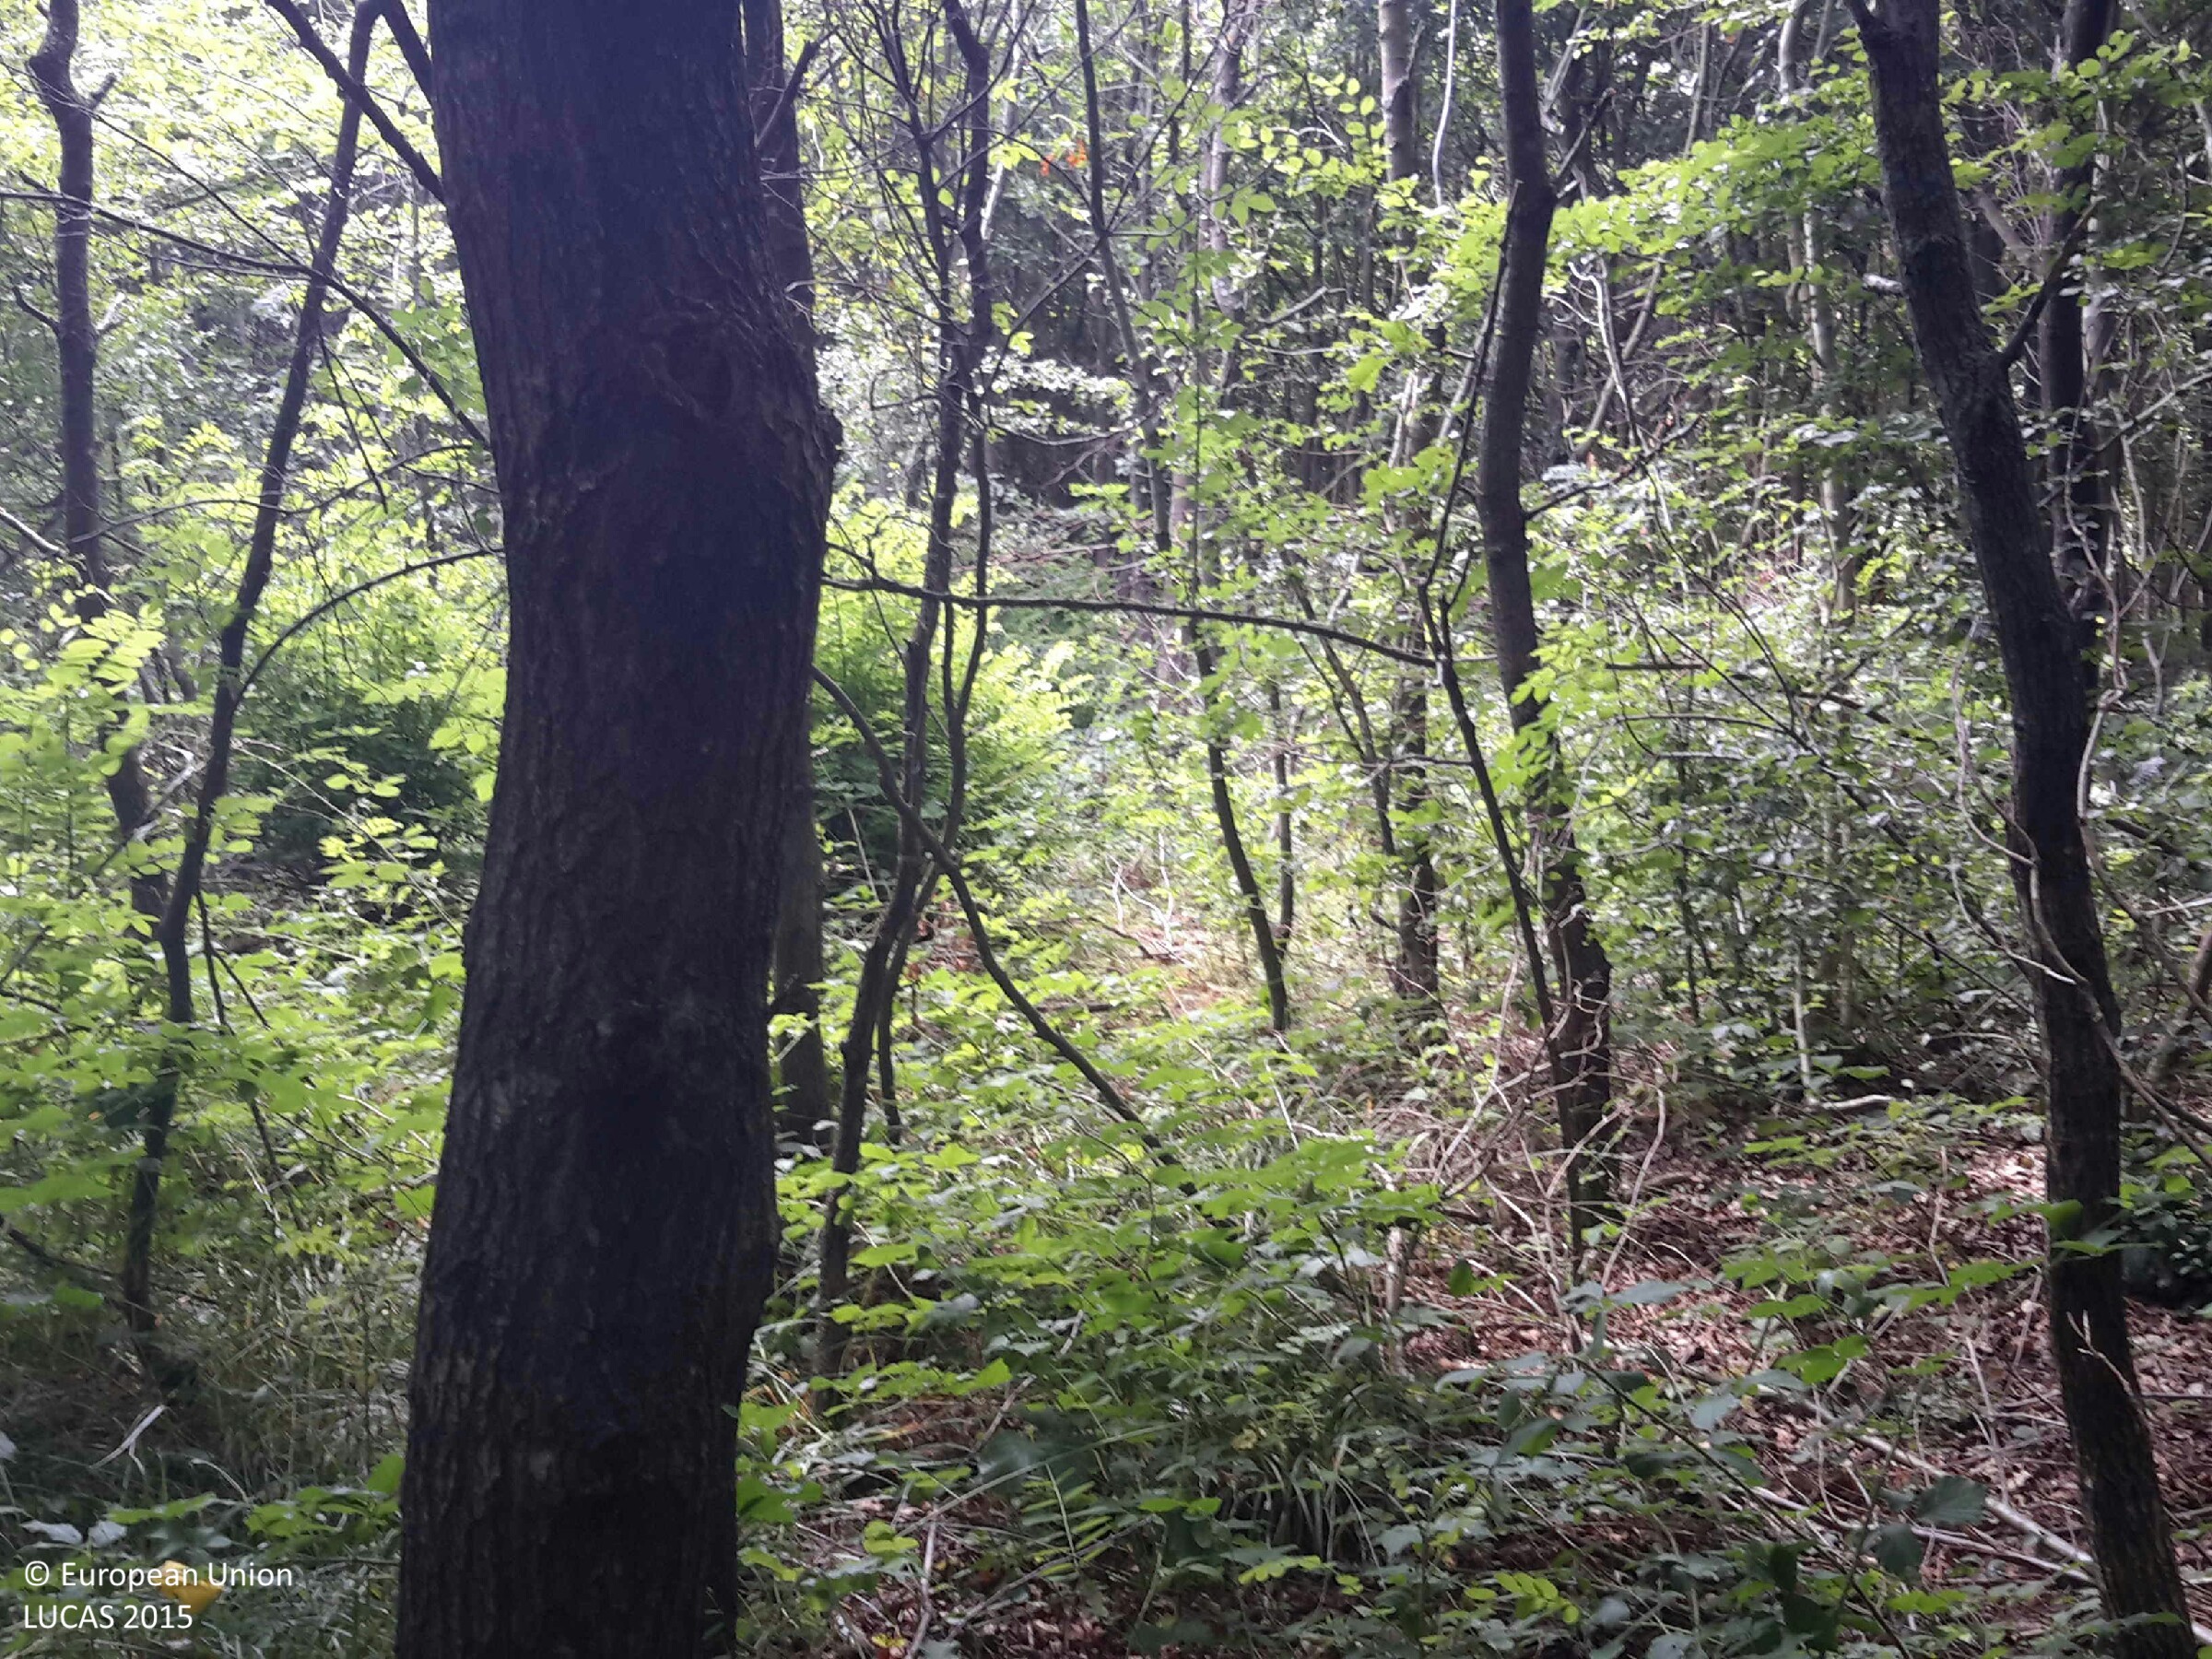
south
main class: Woodland
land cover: Broadleaved woodland
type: acidophilous oak and oak-birch forest
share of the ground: > 75 %
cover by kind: broadleaved forest trees 80 %, herbaceous plants 20 %
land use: Forestry
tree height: > 5 m
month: July
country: HU
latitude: 47.0601
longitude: 17.0220
